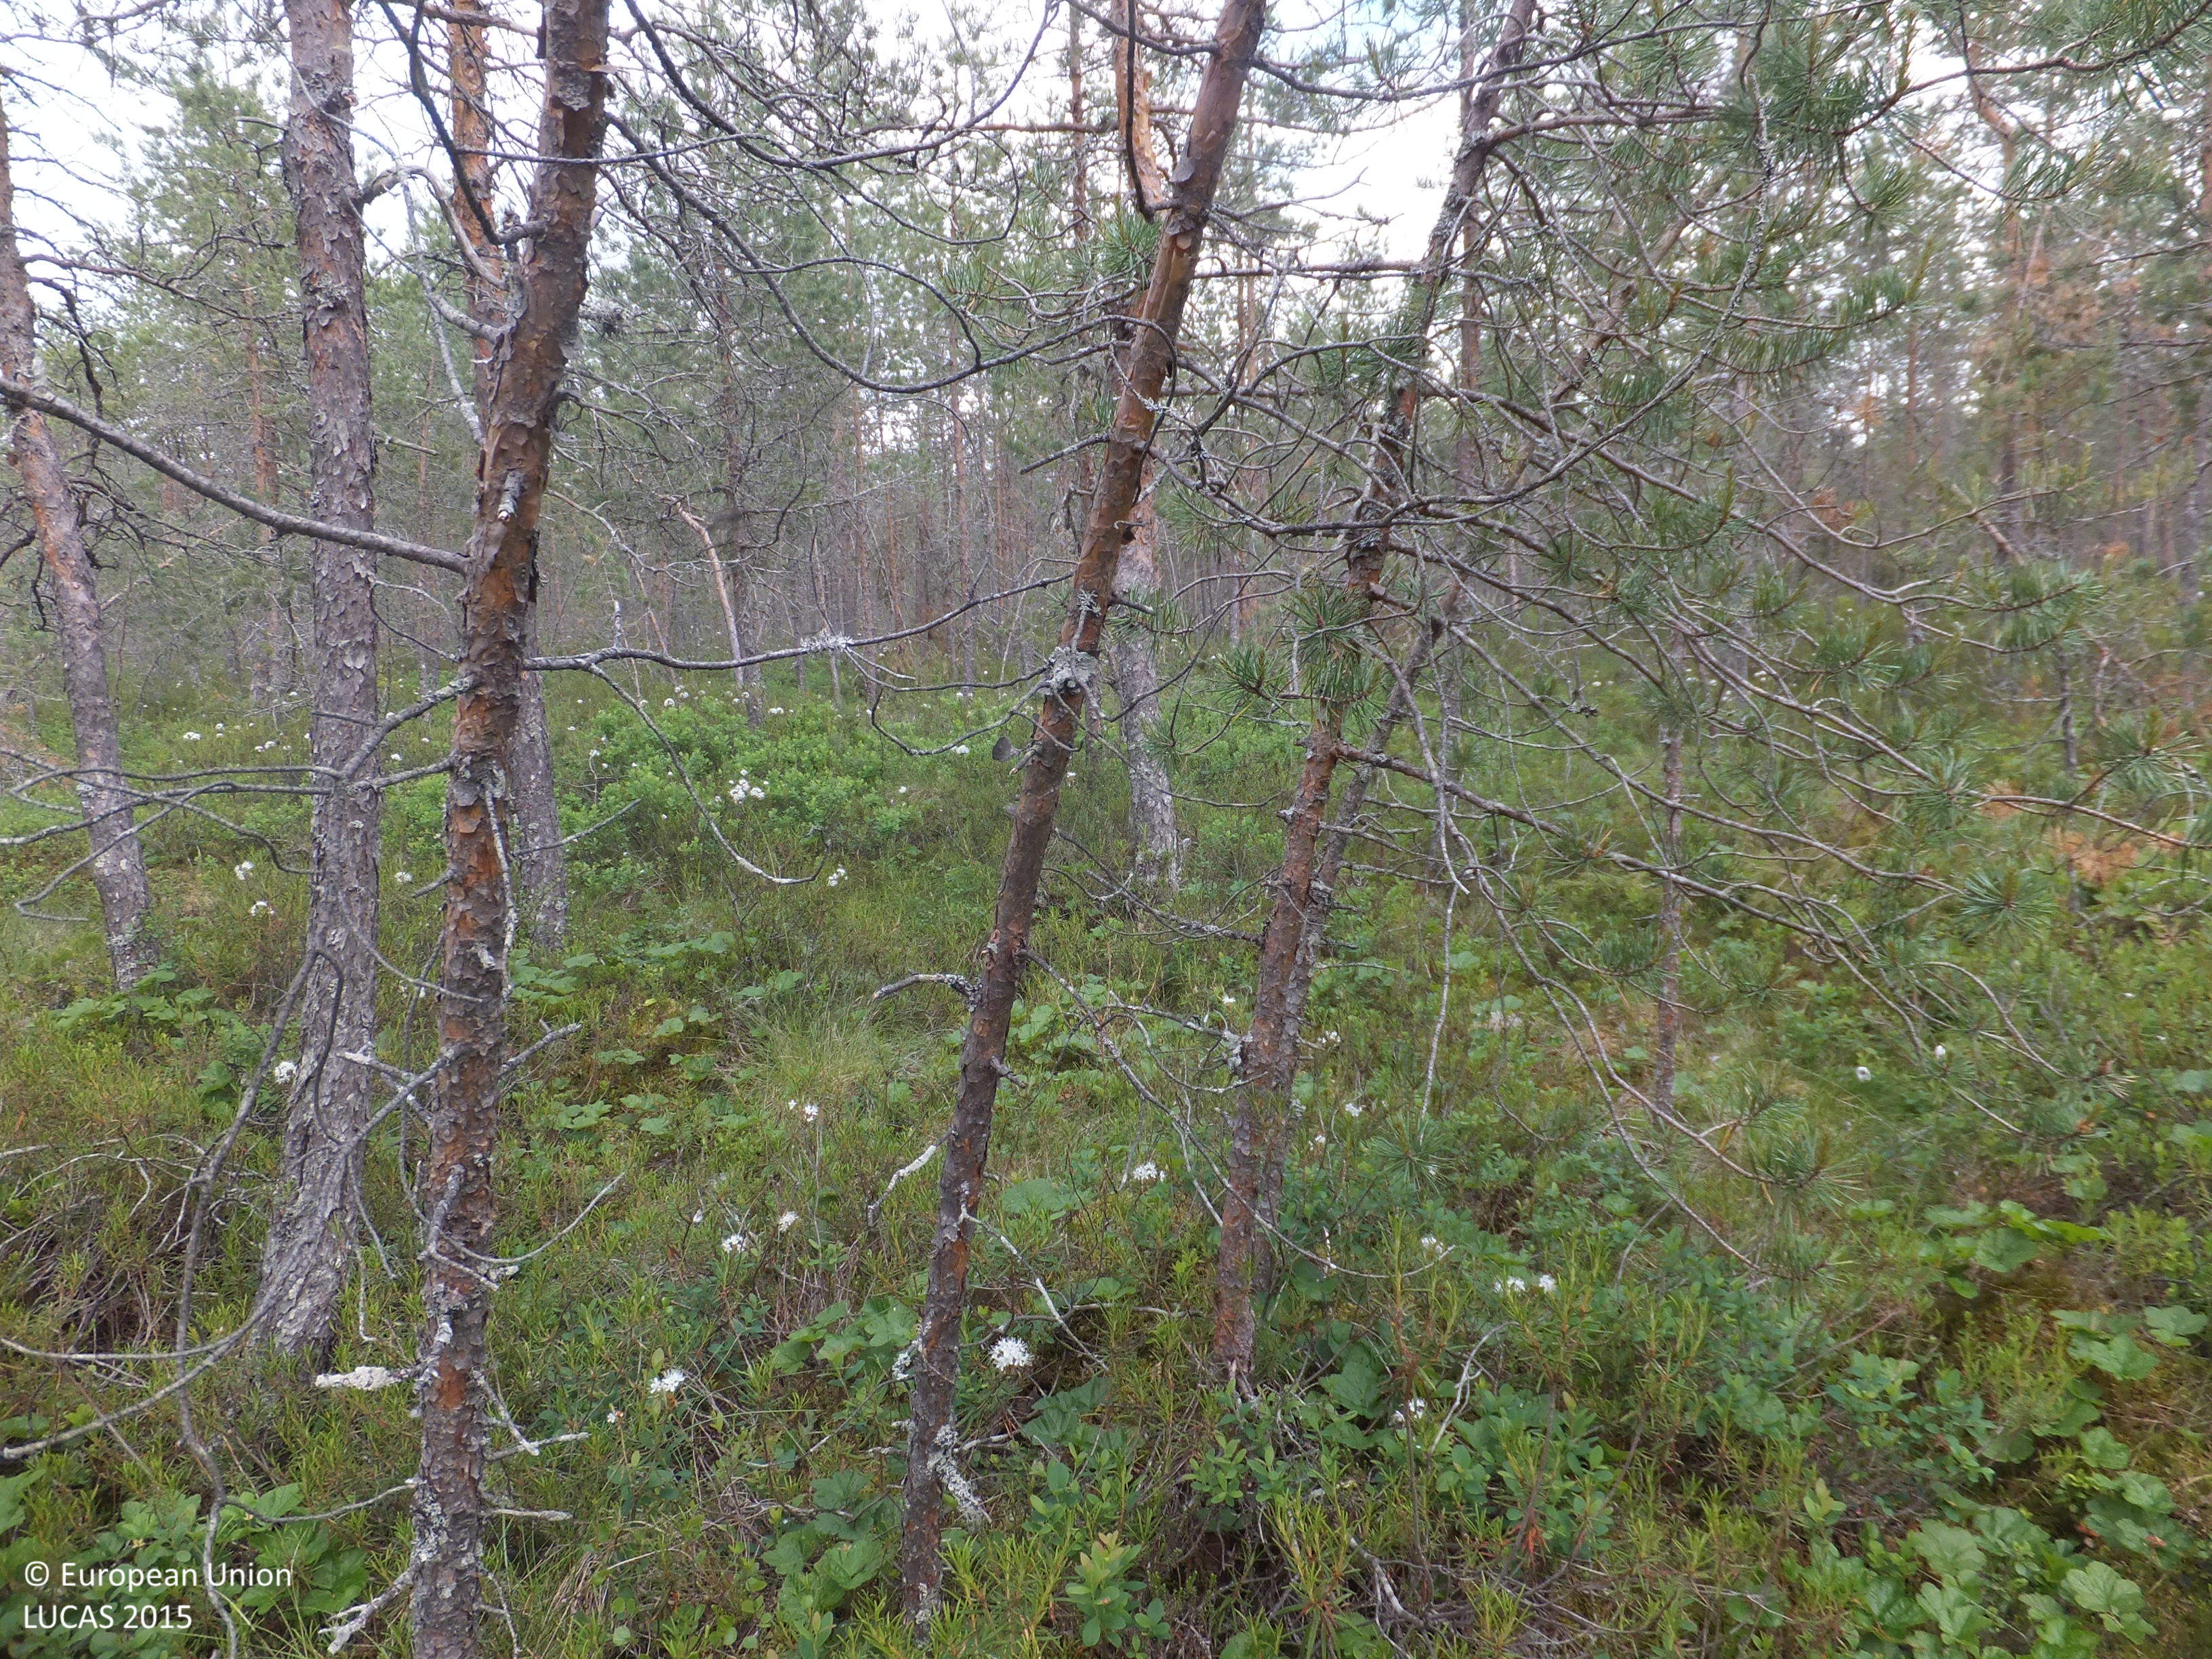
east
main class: Woodland
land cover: Pine dominated coniferous woodland
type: mire and swamp forests
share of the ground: 50 - 75 %
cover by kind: coniferous forest trees 65 %, shrubs 10 %, herbaceous plants 10 %, lichens and mosses 10 %, broadleaved forest trees 5 %
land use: Forestry
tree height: < 5 m
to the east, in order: Pine dominated coniferous woodland; Ditches and canals; Pine dominated coniferous woodland; Ditches and canals; Pine dominated mixed woodland; Other mixed woodland; Ditches and canals; Other mixed woodland; Ditches and canals; Spruce dominated mixed woodland; Ditches and canals; Other mixed woodland
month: June
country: FI
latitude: 63.2730
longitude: 23.8415
